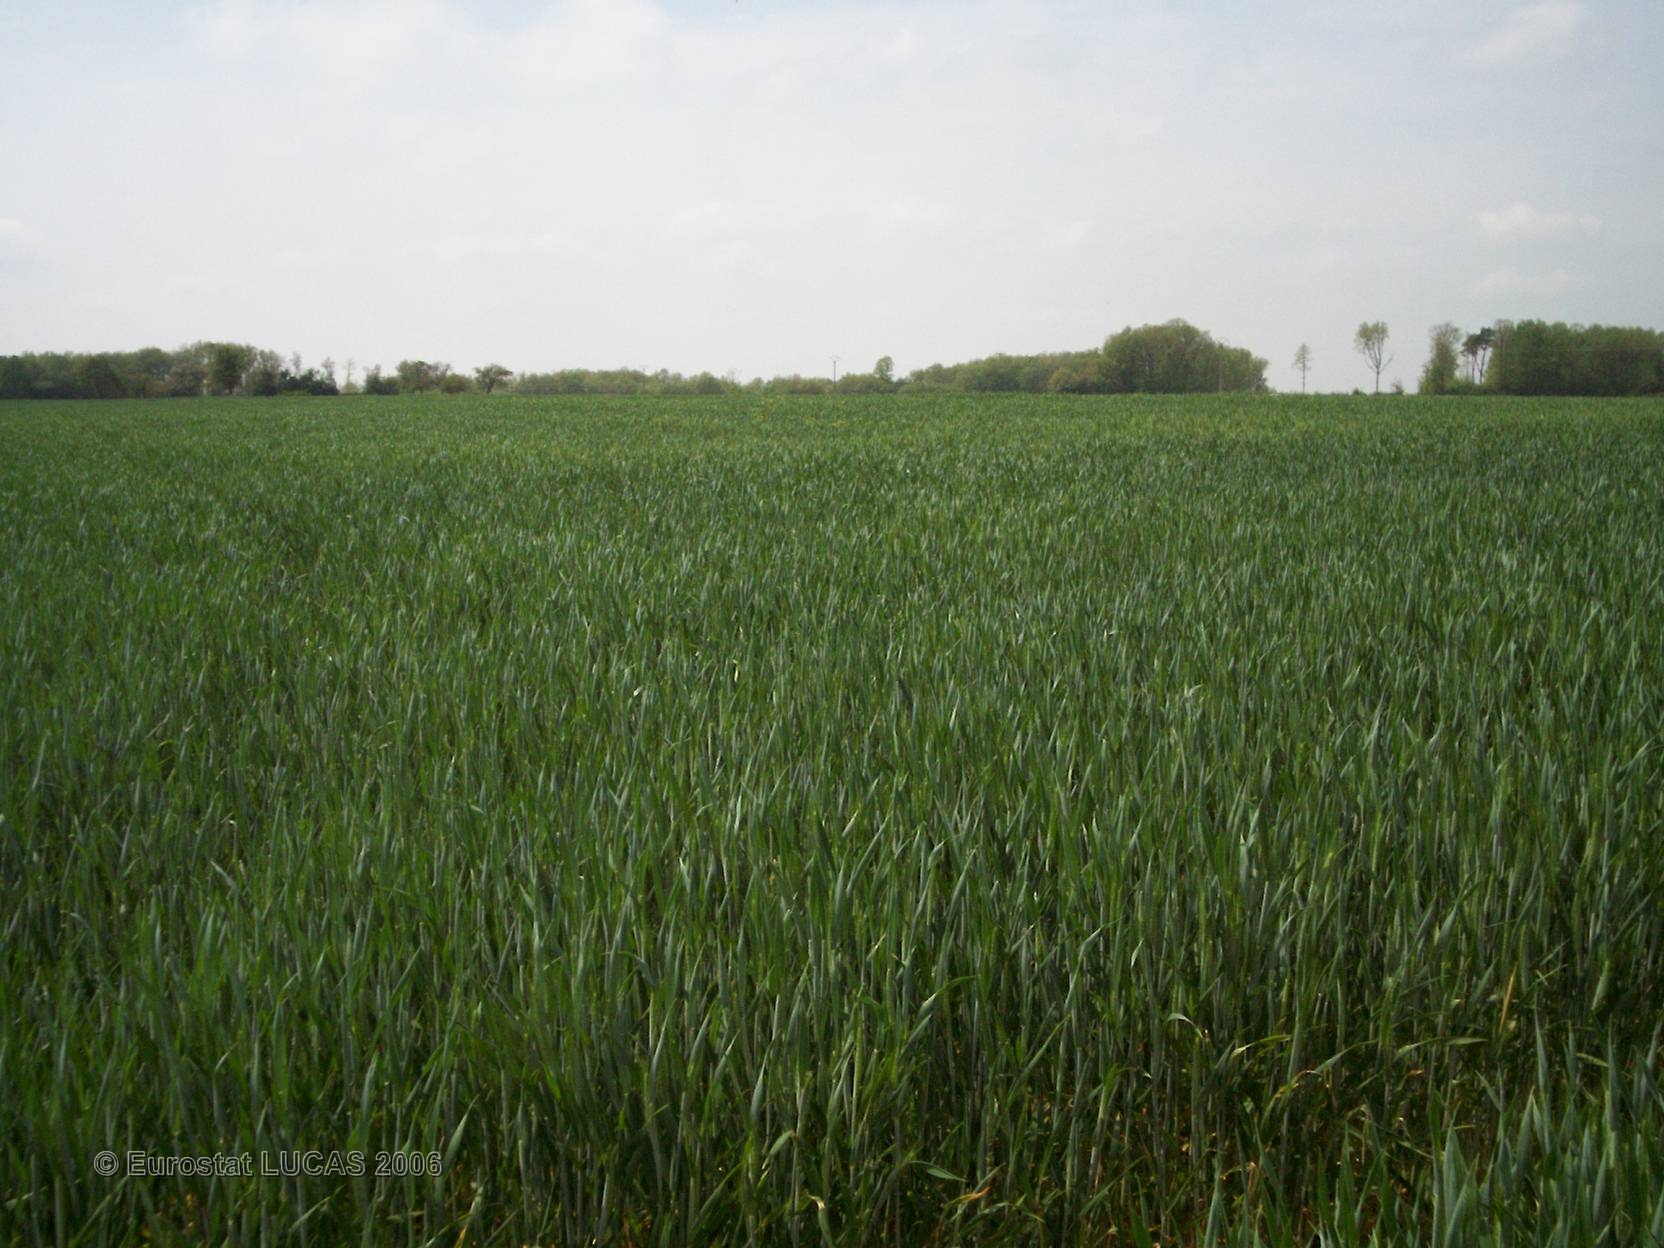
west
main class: Cropland
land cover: Common wheat
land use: Agriculture (excluding fallow land and kitchen gardens)
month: May
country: FR
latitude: 46.6559
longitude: 0.9557
